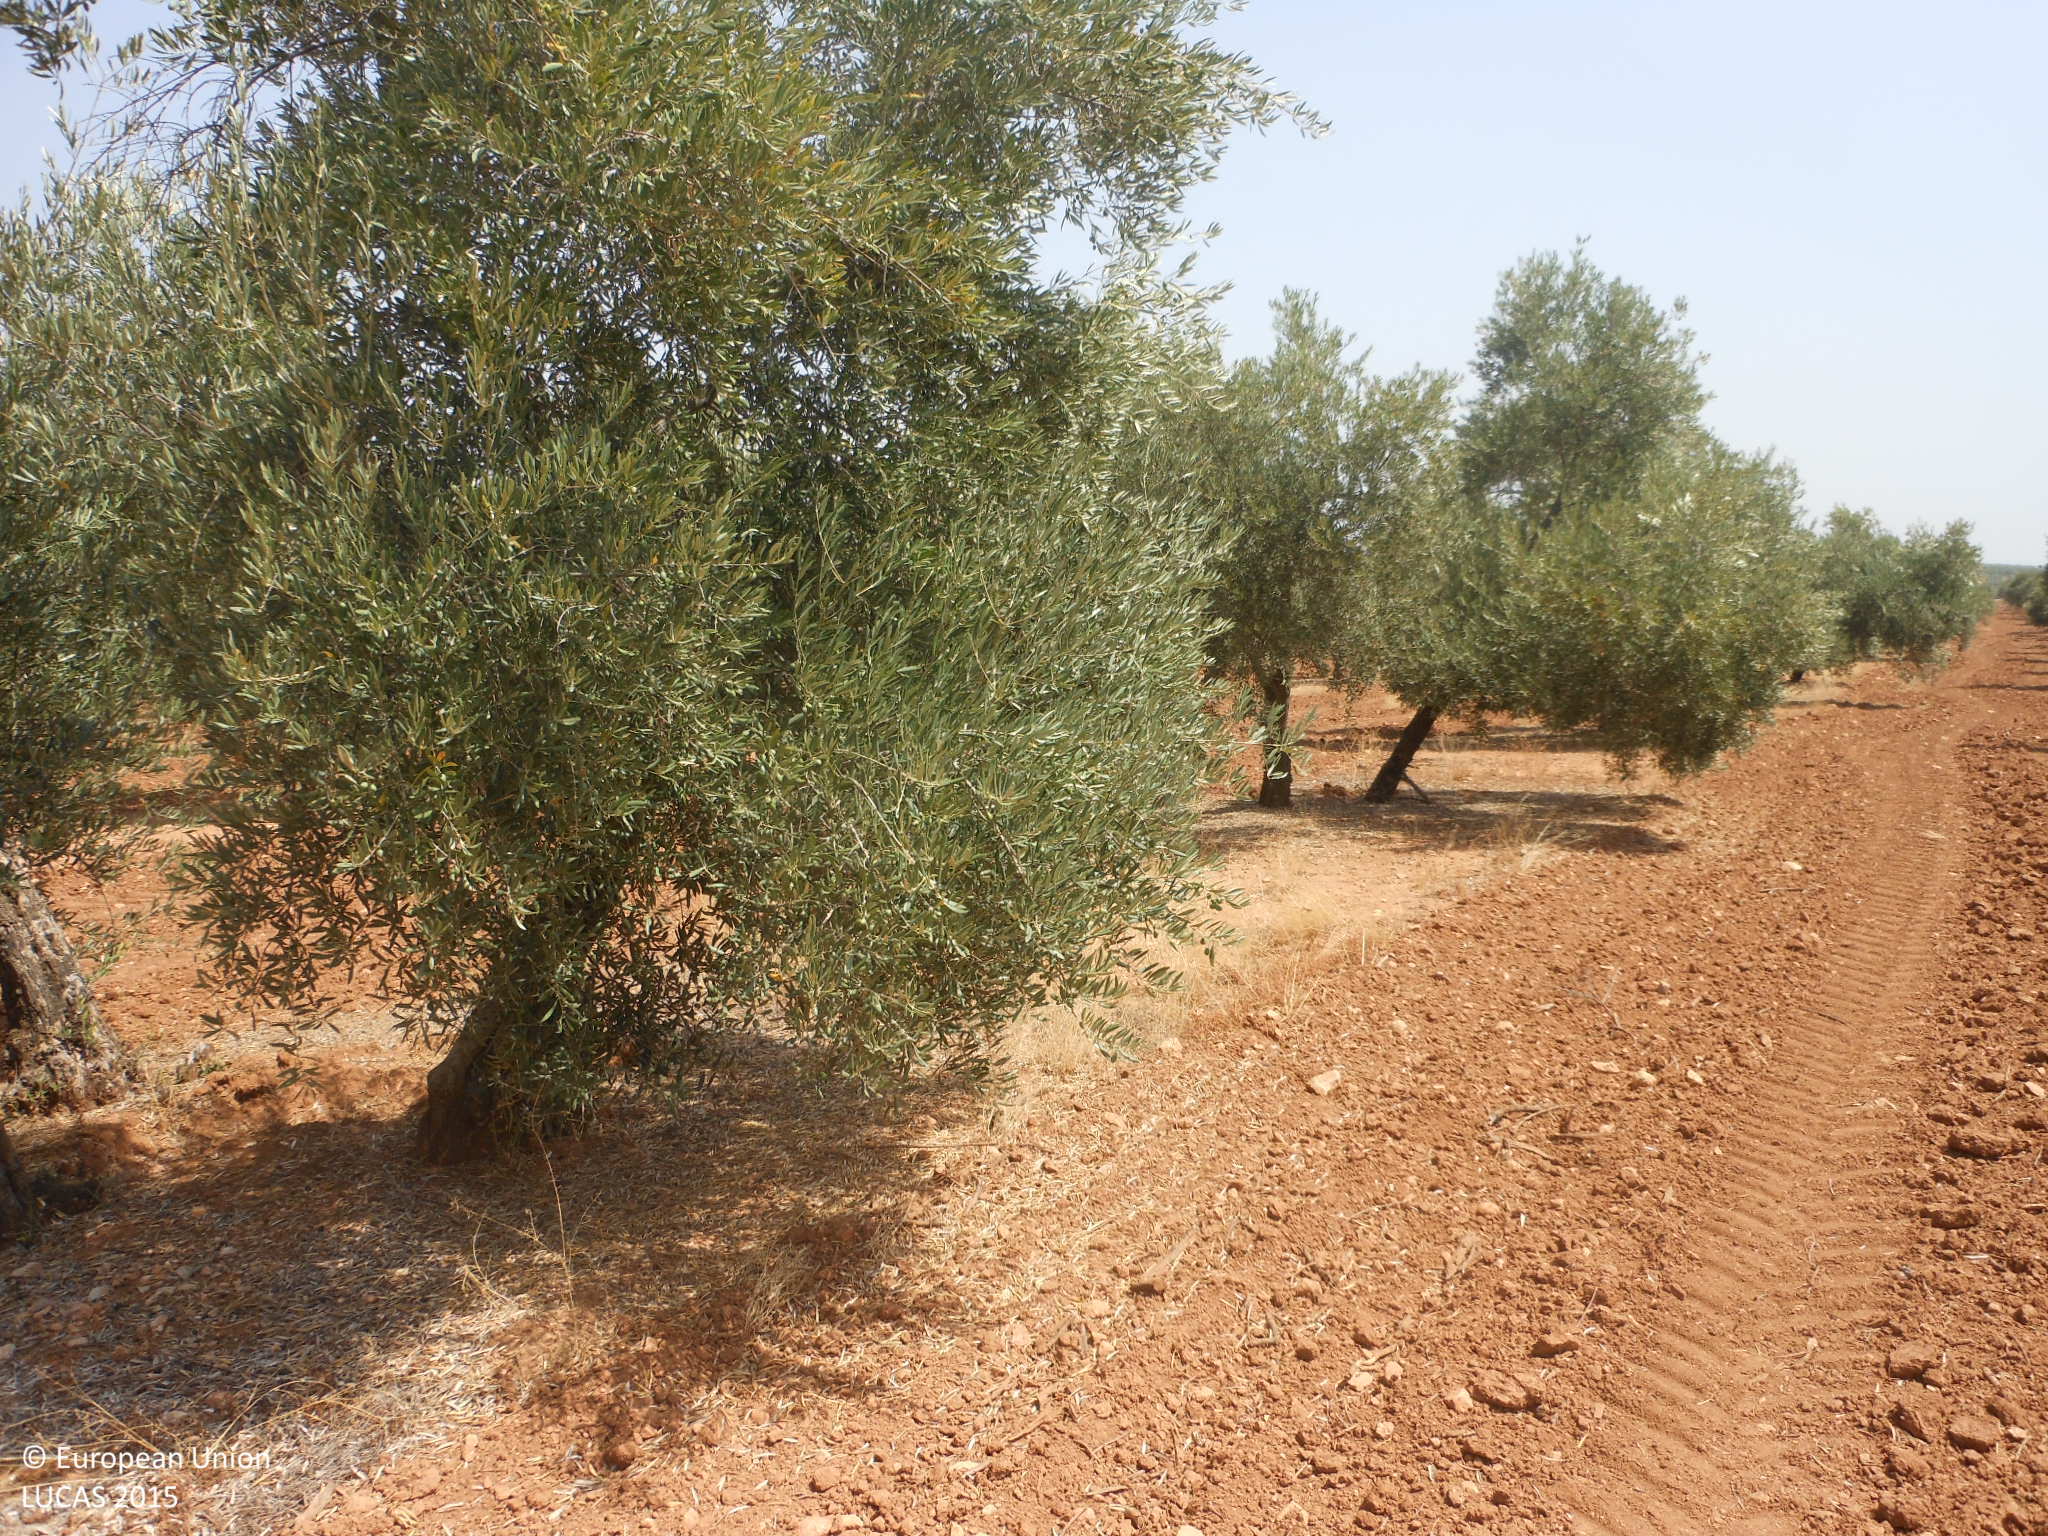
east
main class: Cropland
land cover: Olive groves
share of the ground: 25 - 50 %
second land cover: Other bare soil
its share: > 75 %
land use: Agriculture (excluding fallow land and kitchen gardens)
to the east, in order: Olive groves; Other bare soil; Rivers and streams; Olive groves
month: July
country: ES
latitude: 37.3403
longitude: -4.8948
